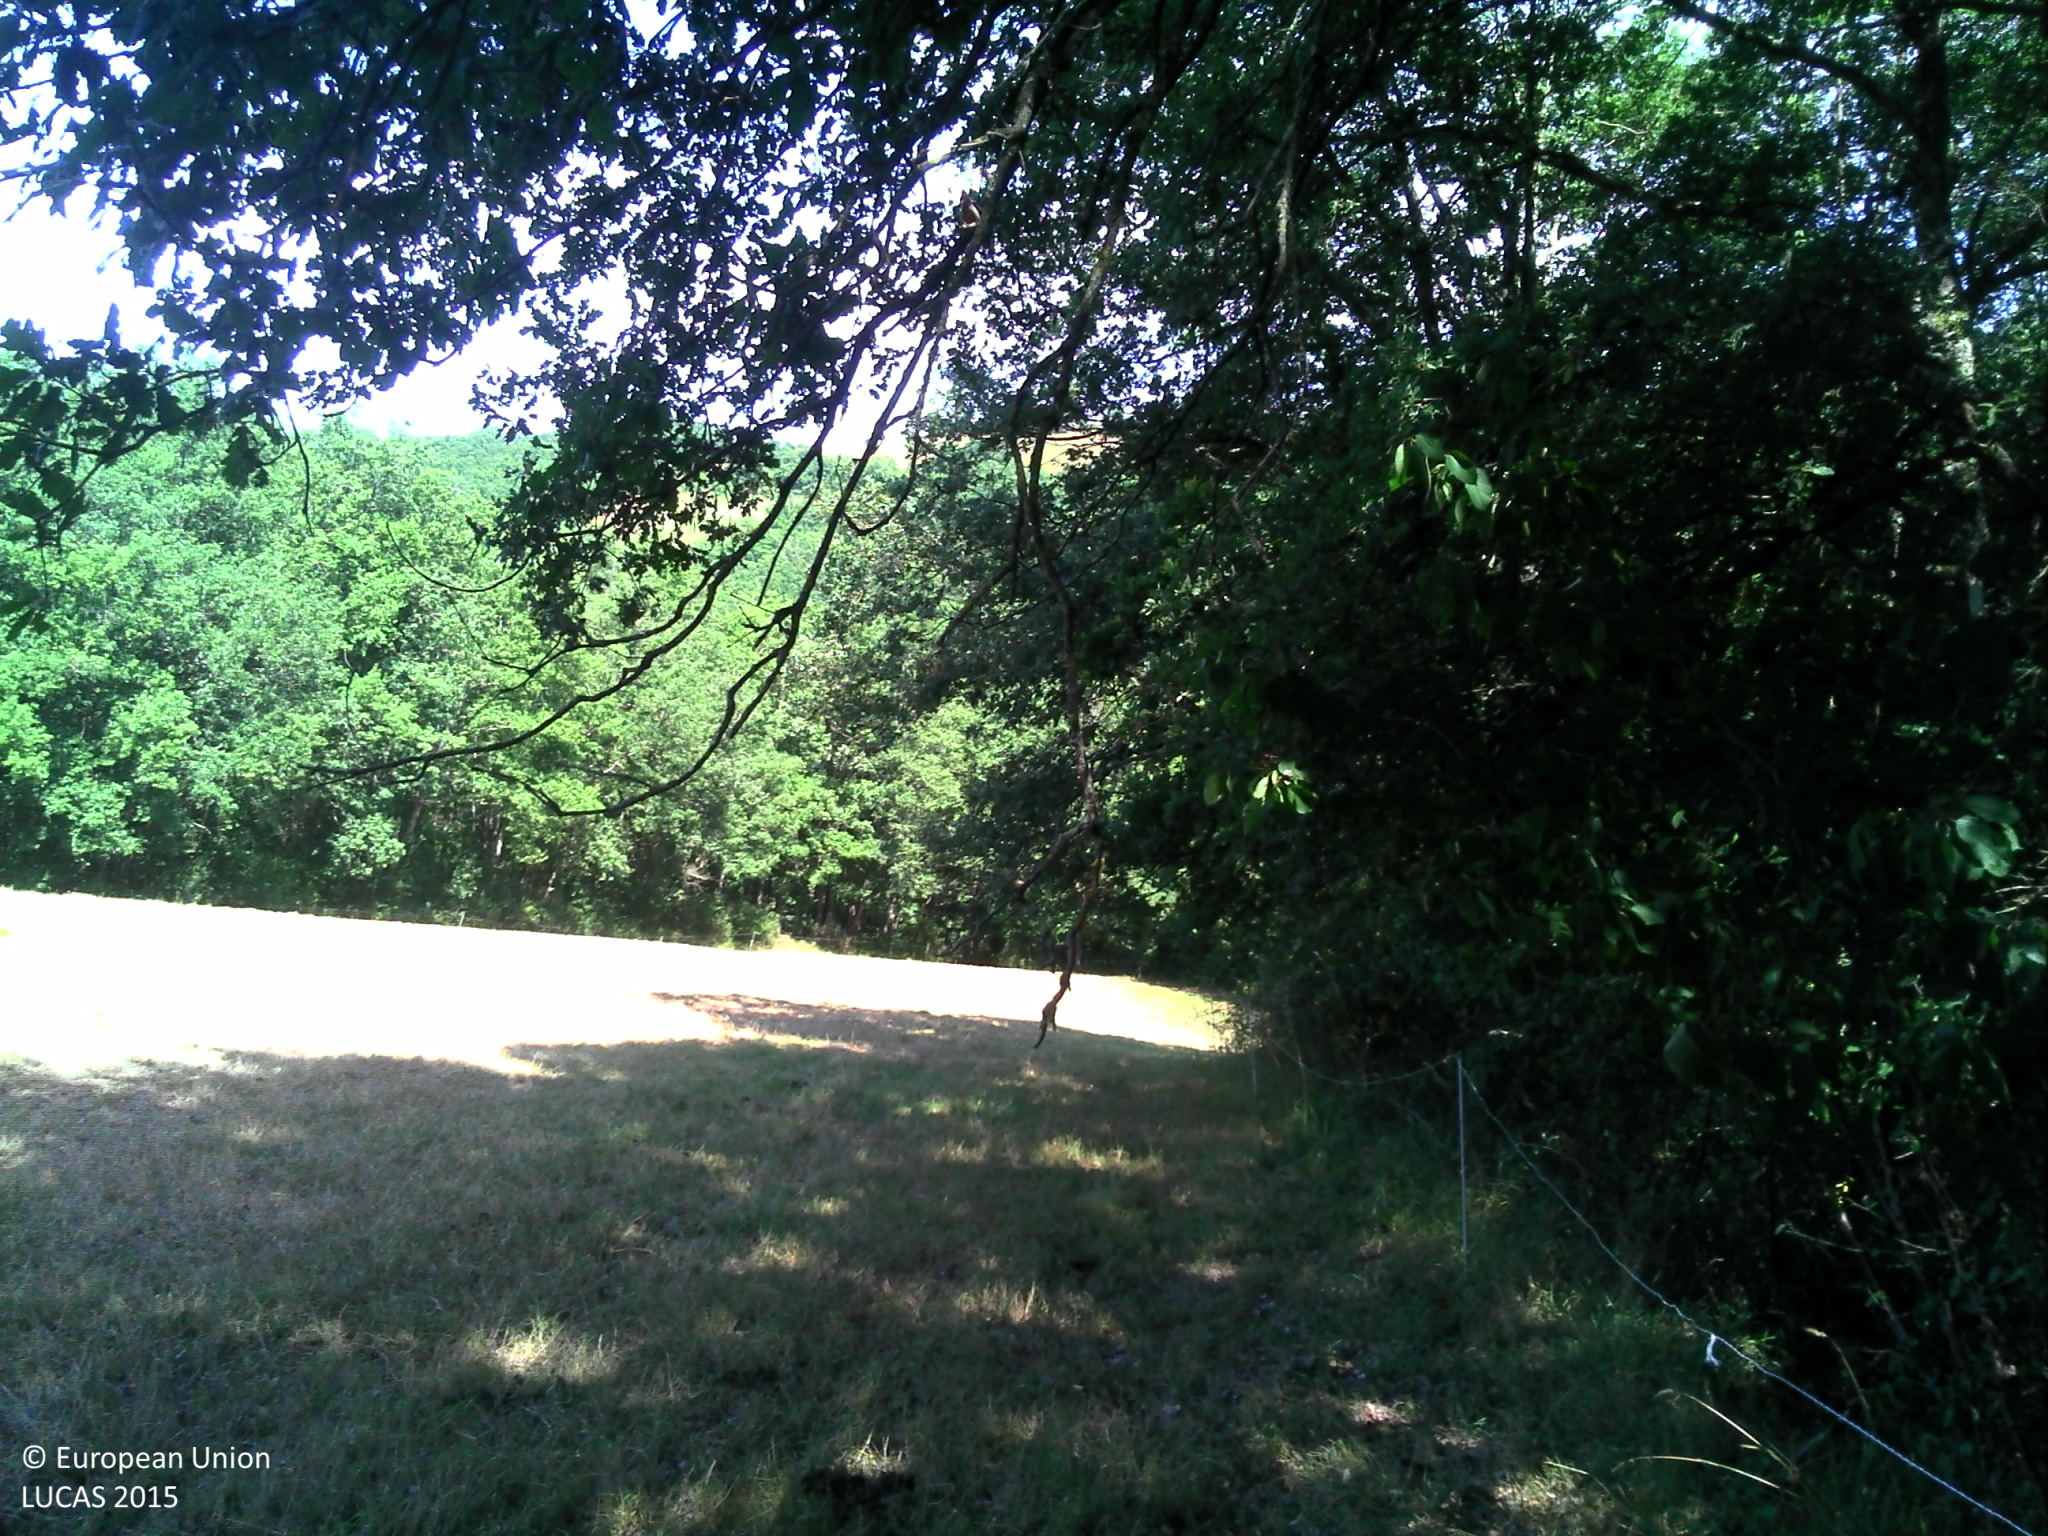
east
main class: Grassland
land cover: Grassland without tree/shrub cover
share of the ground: > 75 %
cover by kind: herbaceous plants 100 %
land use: Agriculture (excluding fallow land and kitchen gardens)
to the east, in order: Grassland without tree/shrub cover; Broadleaved woodland; Grassland without tree/shrub cover; Fences; Broadleaved woodland; Rivers and streams; Broadleaved woodland; Arable land (only in case pi)
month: July
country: FR
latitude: 43.1765
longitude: 1.1833
